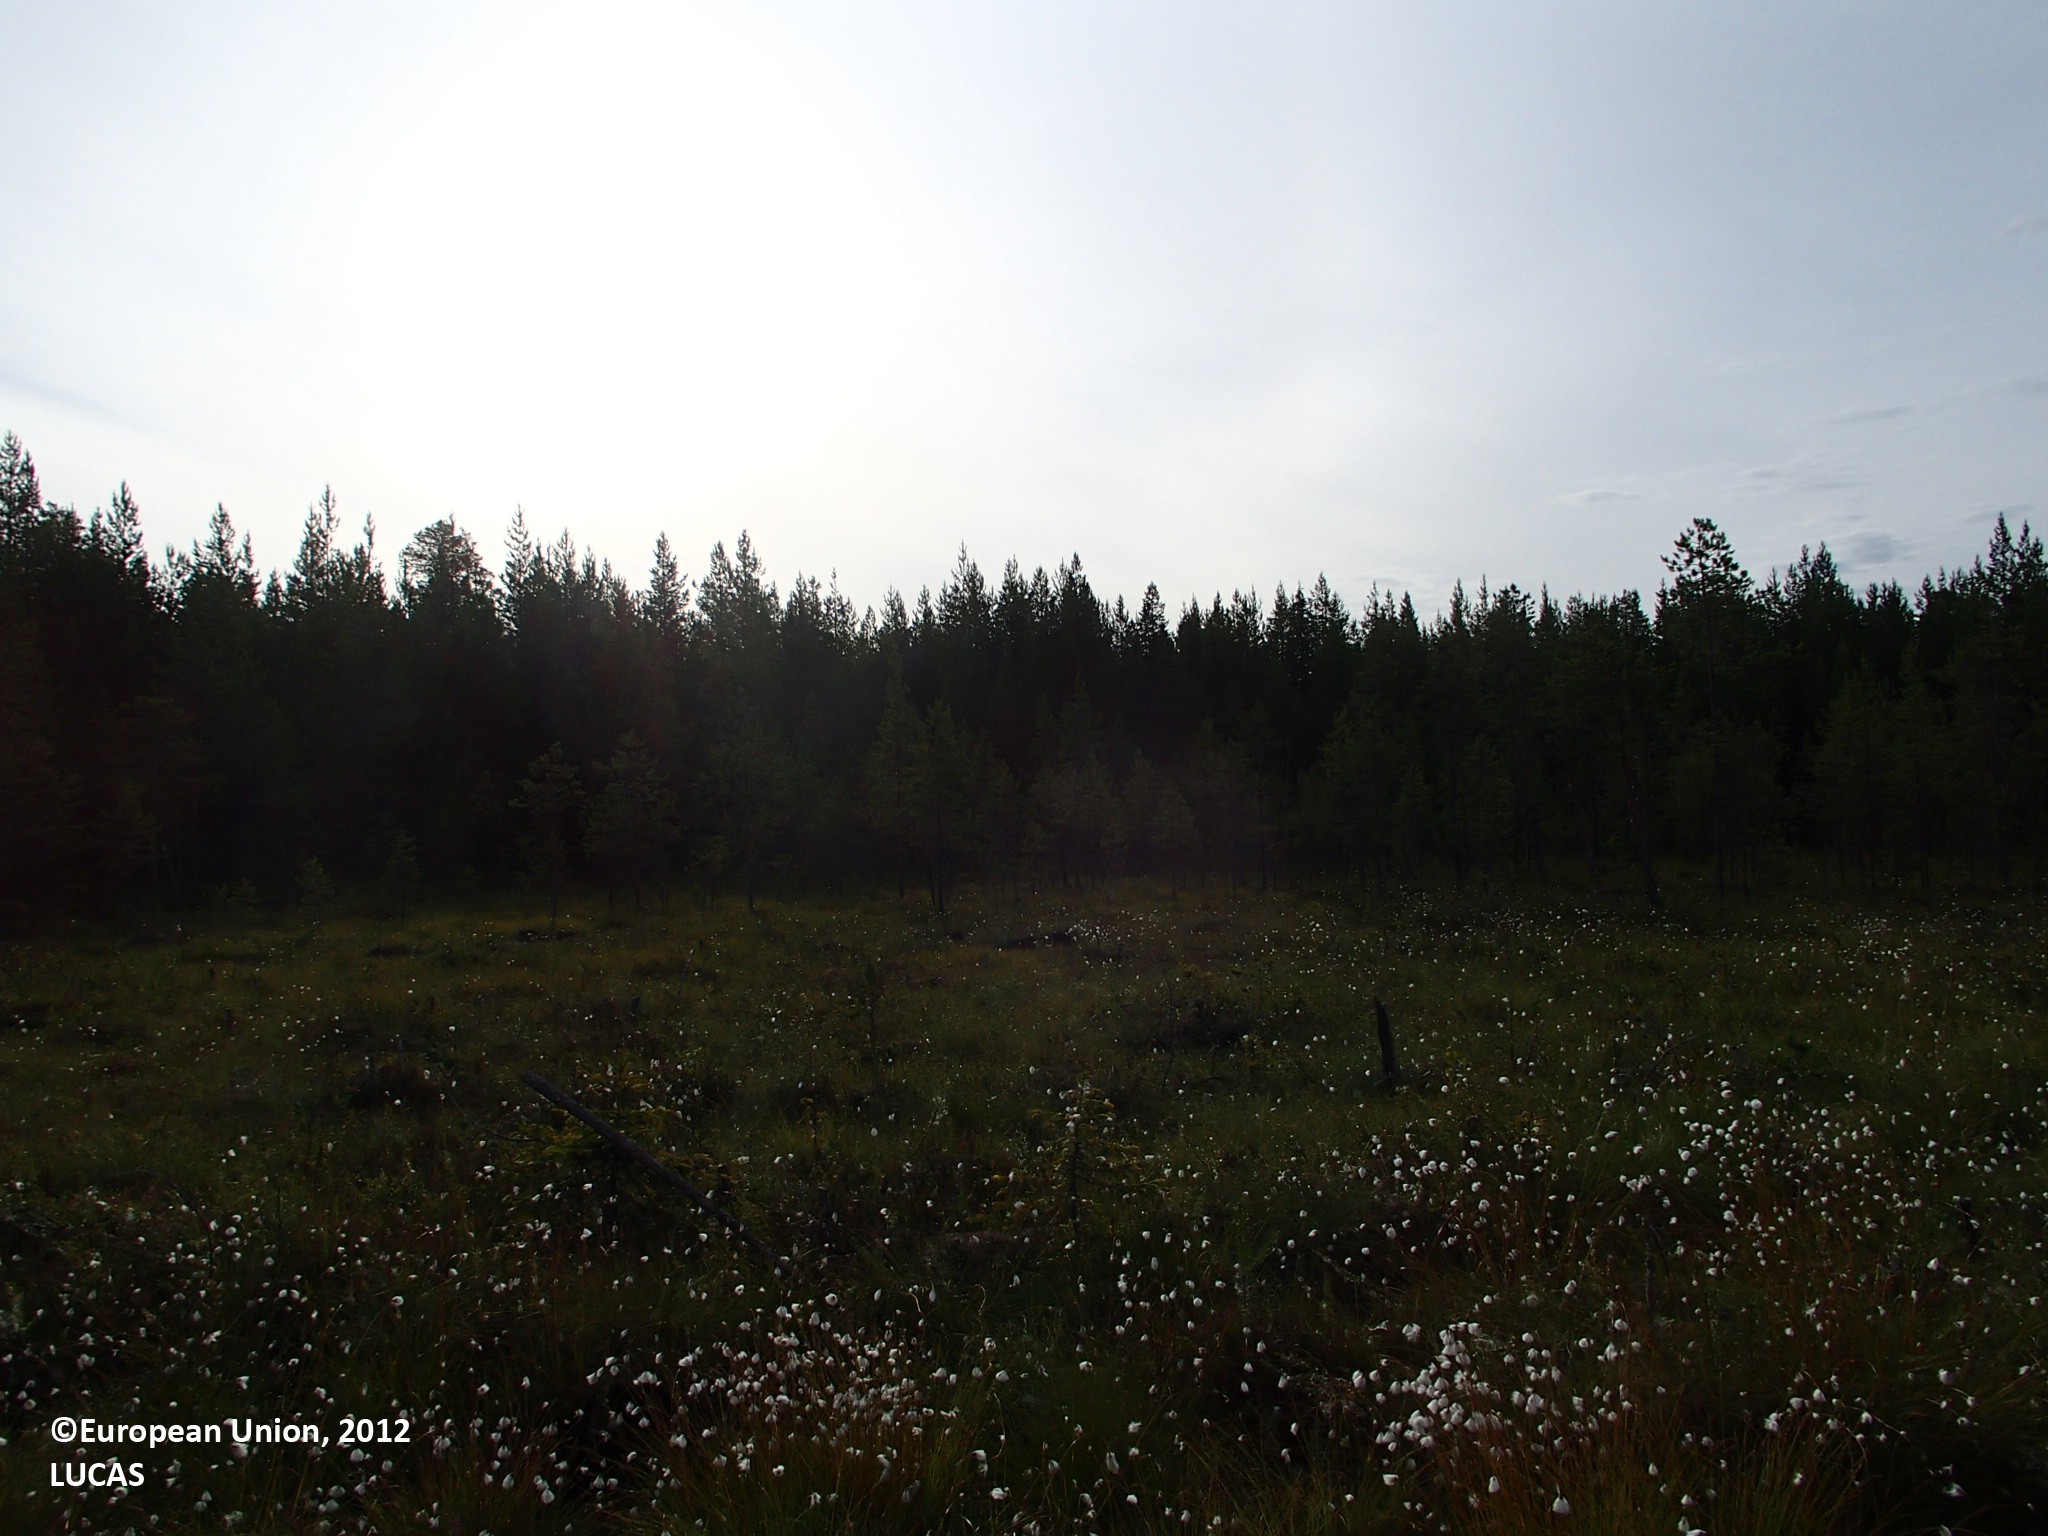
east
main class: Grassland
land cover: Grassland with sparse tree/shrub cover
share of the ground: > 75 %
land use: Energy production
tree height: < 5 m
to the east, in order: Grassland with sparse tree/shrub cover; Electric lines; Grassland with sparse tree/shrub cover; Pine dominated coniferous woodland; Other coniferous woodland; Pine dominated coniferous woodland; Peatbogs
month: July
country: FI
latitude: 66.4382
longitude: 25.5571
